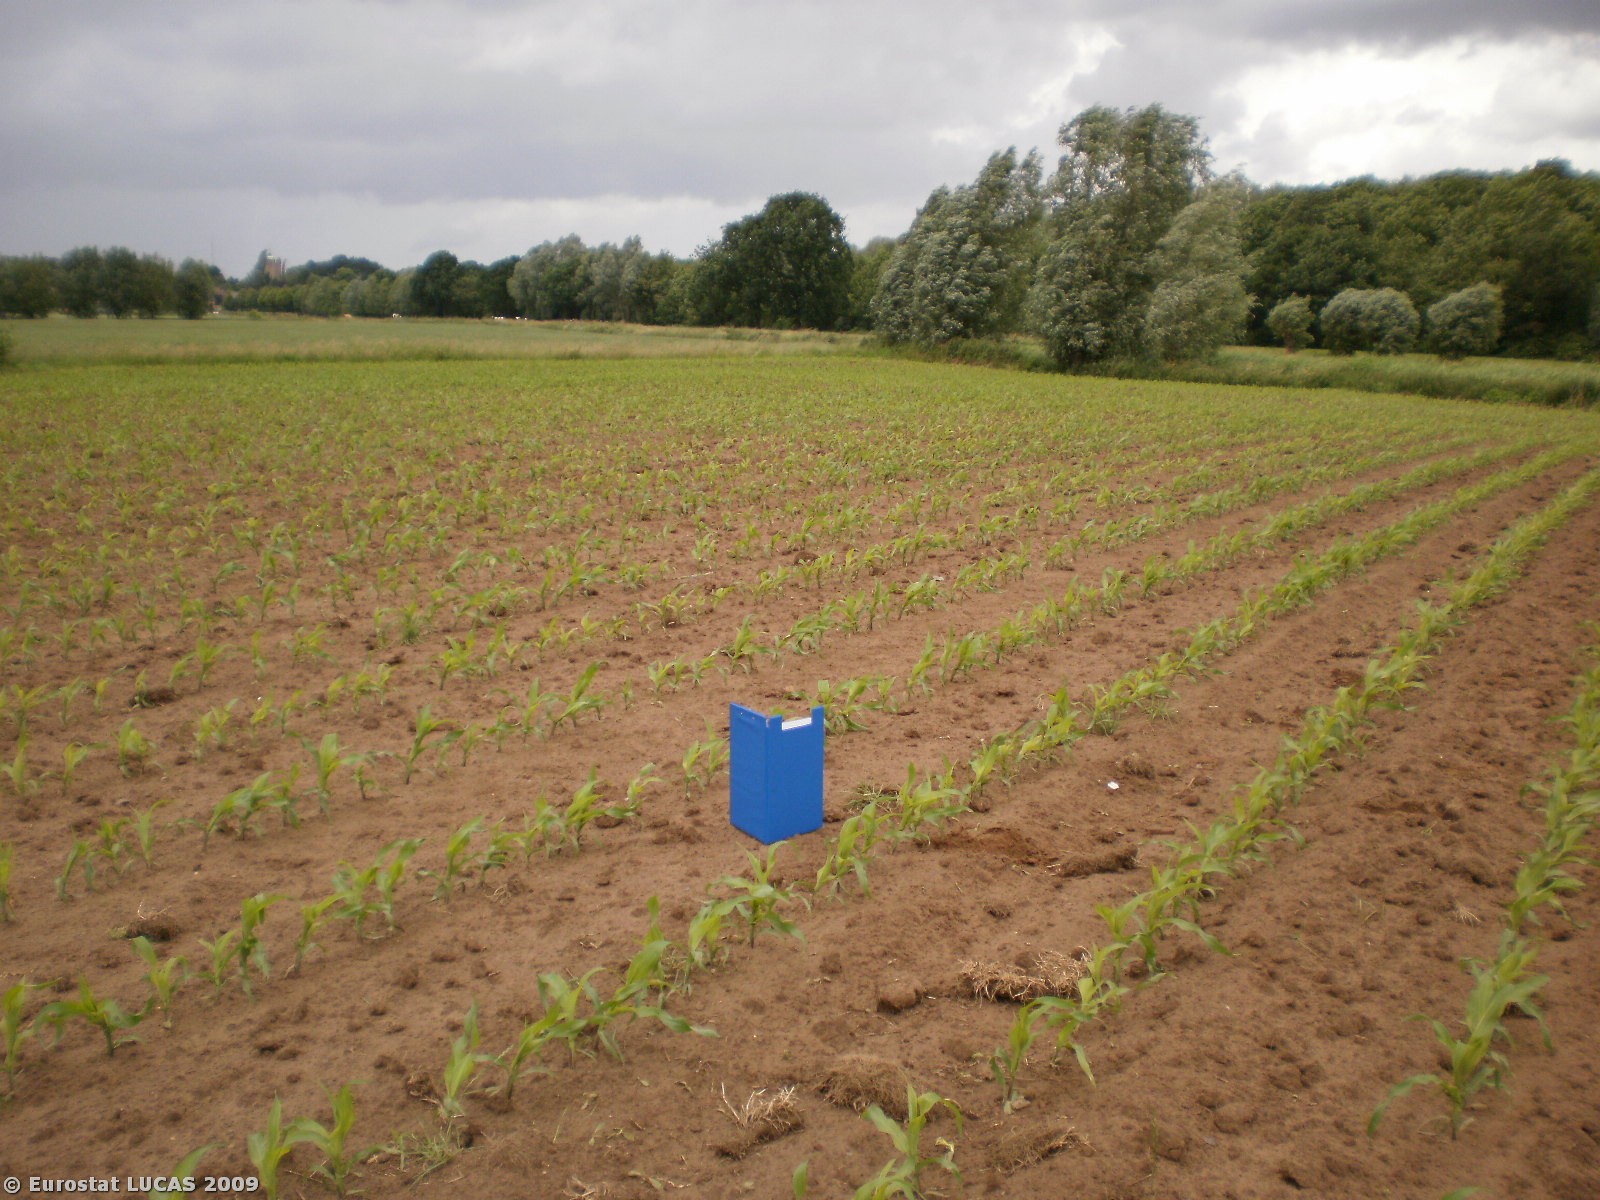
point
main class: Cropland
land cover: Maize
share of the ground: 10 - 25 %
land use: Agriculture (excluding fallow land and kitchen gardens)
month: June
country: BE
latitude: 51.0843
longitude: 4.2419
